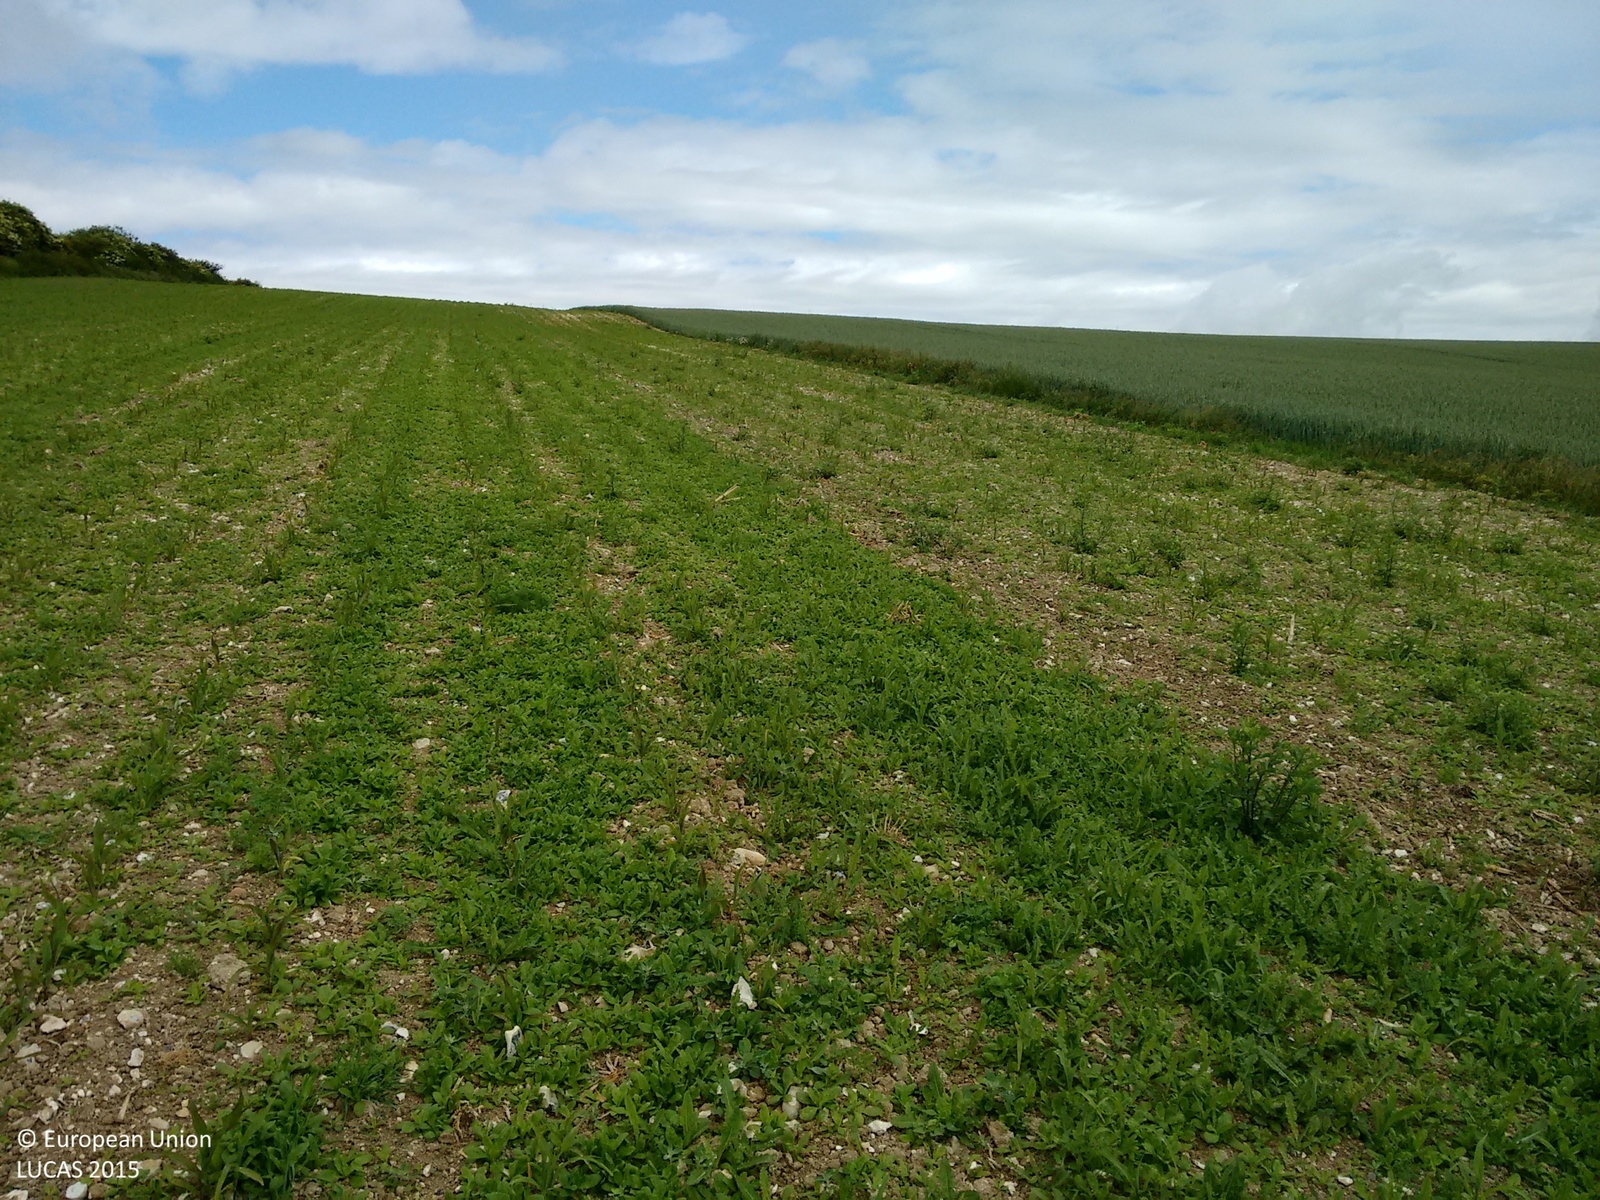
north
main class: Cropland
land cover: Maize
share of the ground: 10 - 25 %
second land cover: Spontaneously vegetated surfaces
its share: > 75 %
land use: Agriculture (excluding fallow land and kitchen gardens)
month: June
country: GB
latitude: 51.5200
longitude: -1.1873
